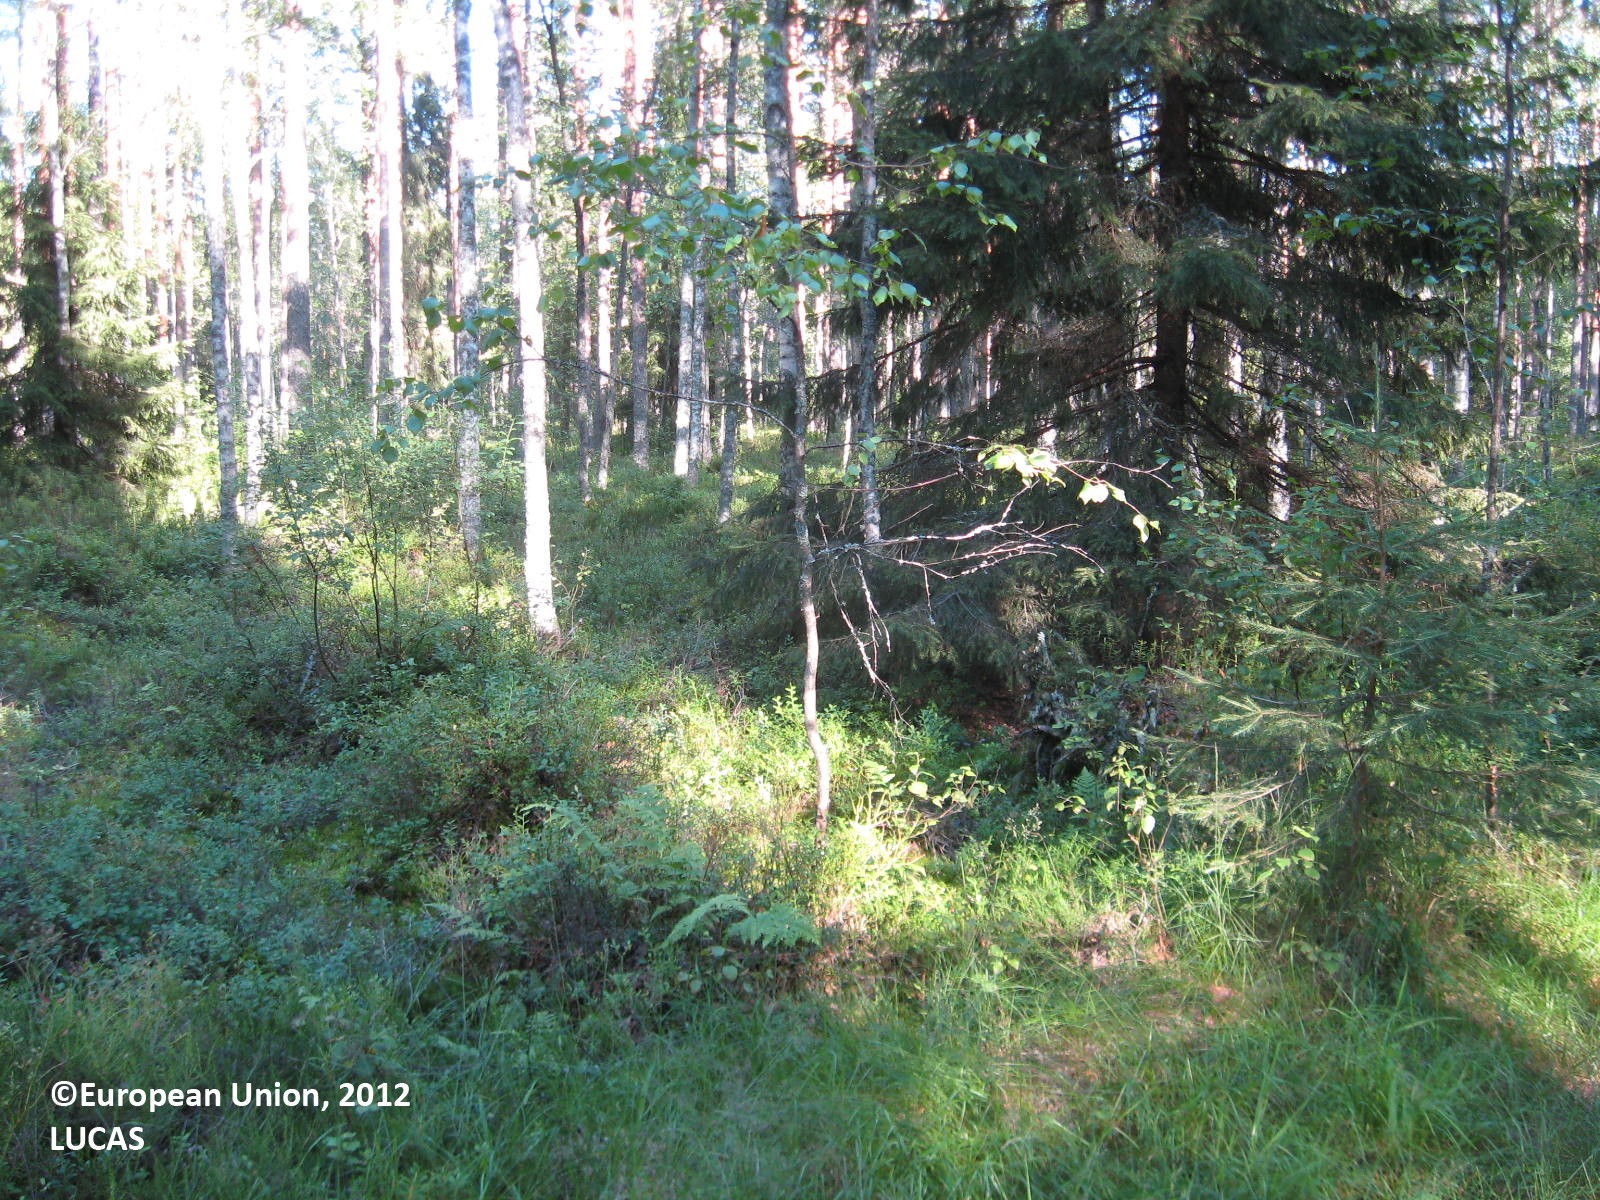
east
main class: Woodland
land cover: Pine dominated mixed woodland
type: boreal forest
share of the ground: > 75 %
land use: Forestry
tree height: > 5 m
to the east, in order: Pine dominated mixed woodland; Tracks; Pine dominated mixed woodland; Ditches and canals; Pine dominated mixed woodland; Ditches and canals; Other mixed woodland; Tracks; Other mixed woodland; Ditches and canals; Other mixed woodland; Ditches and canals; Other mixed woodland
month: July
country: FI
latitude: 62.0579
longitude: 22.4355
